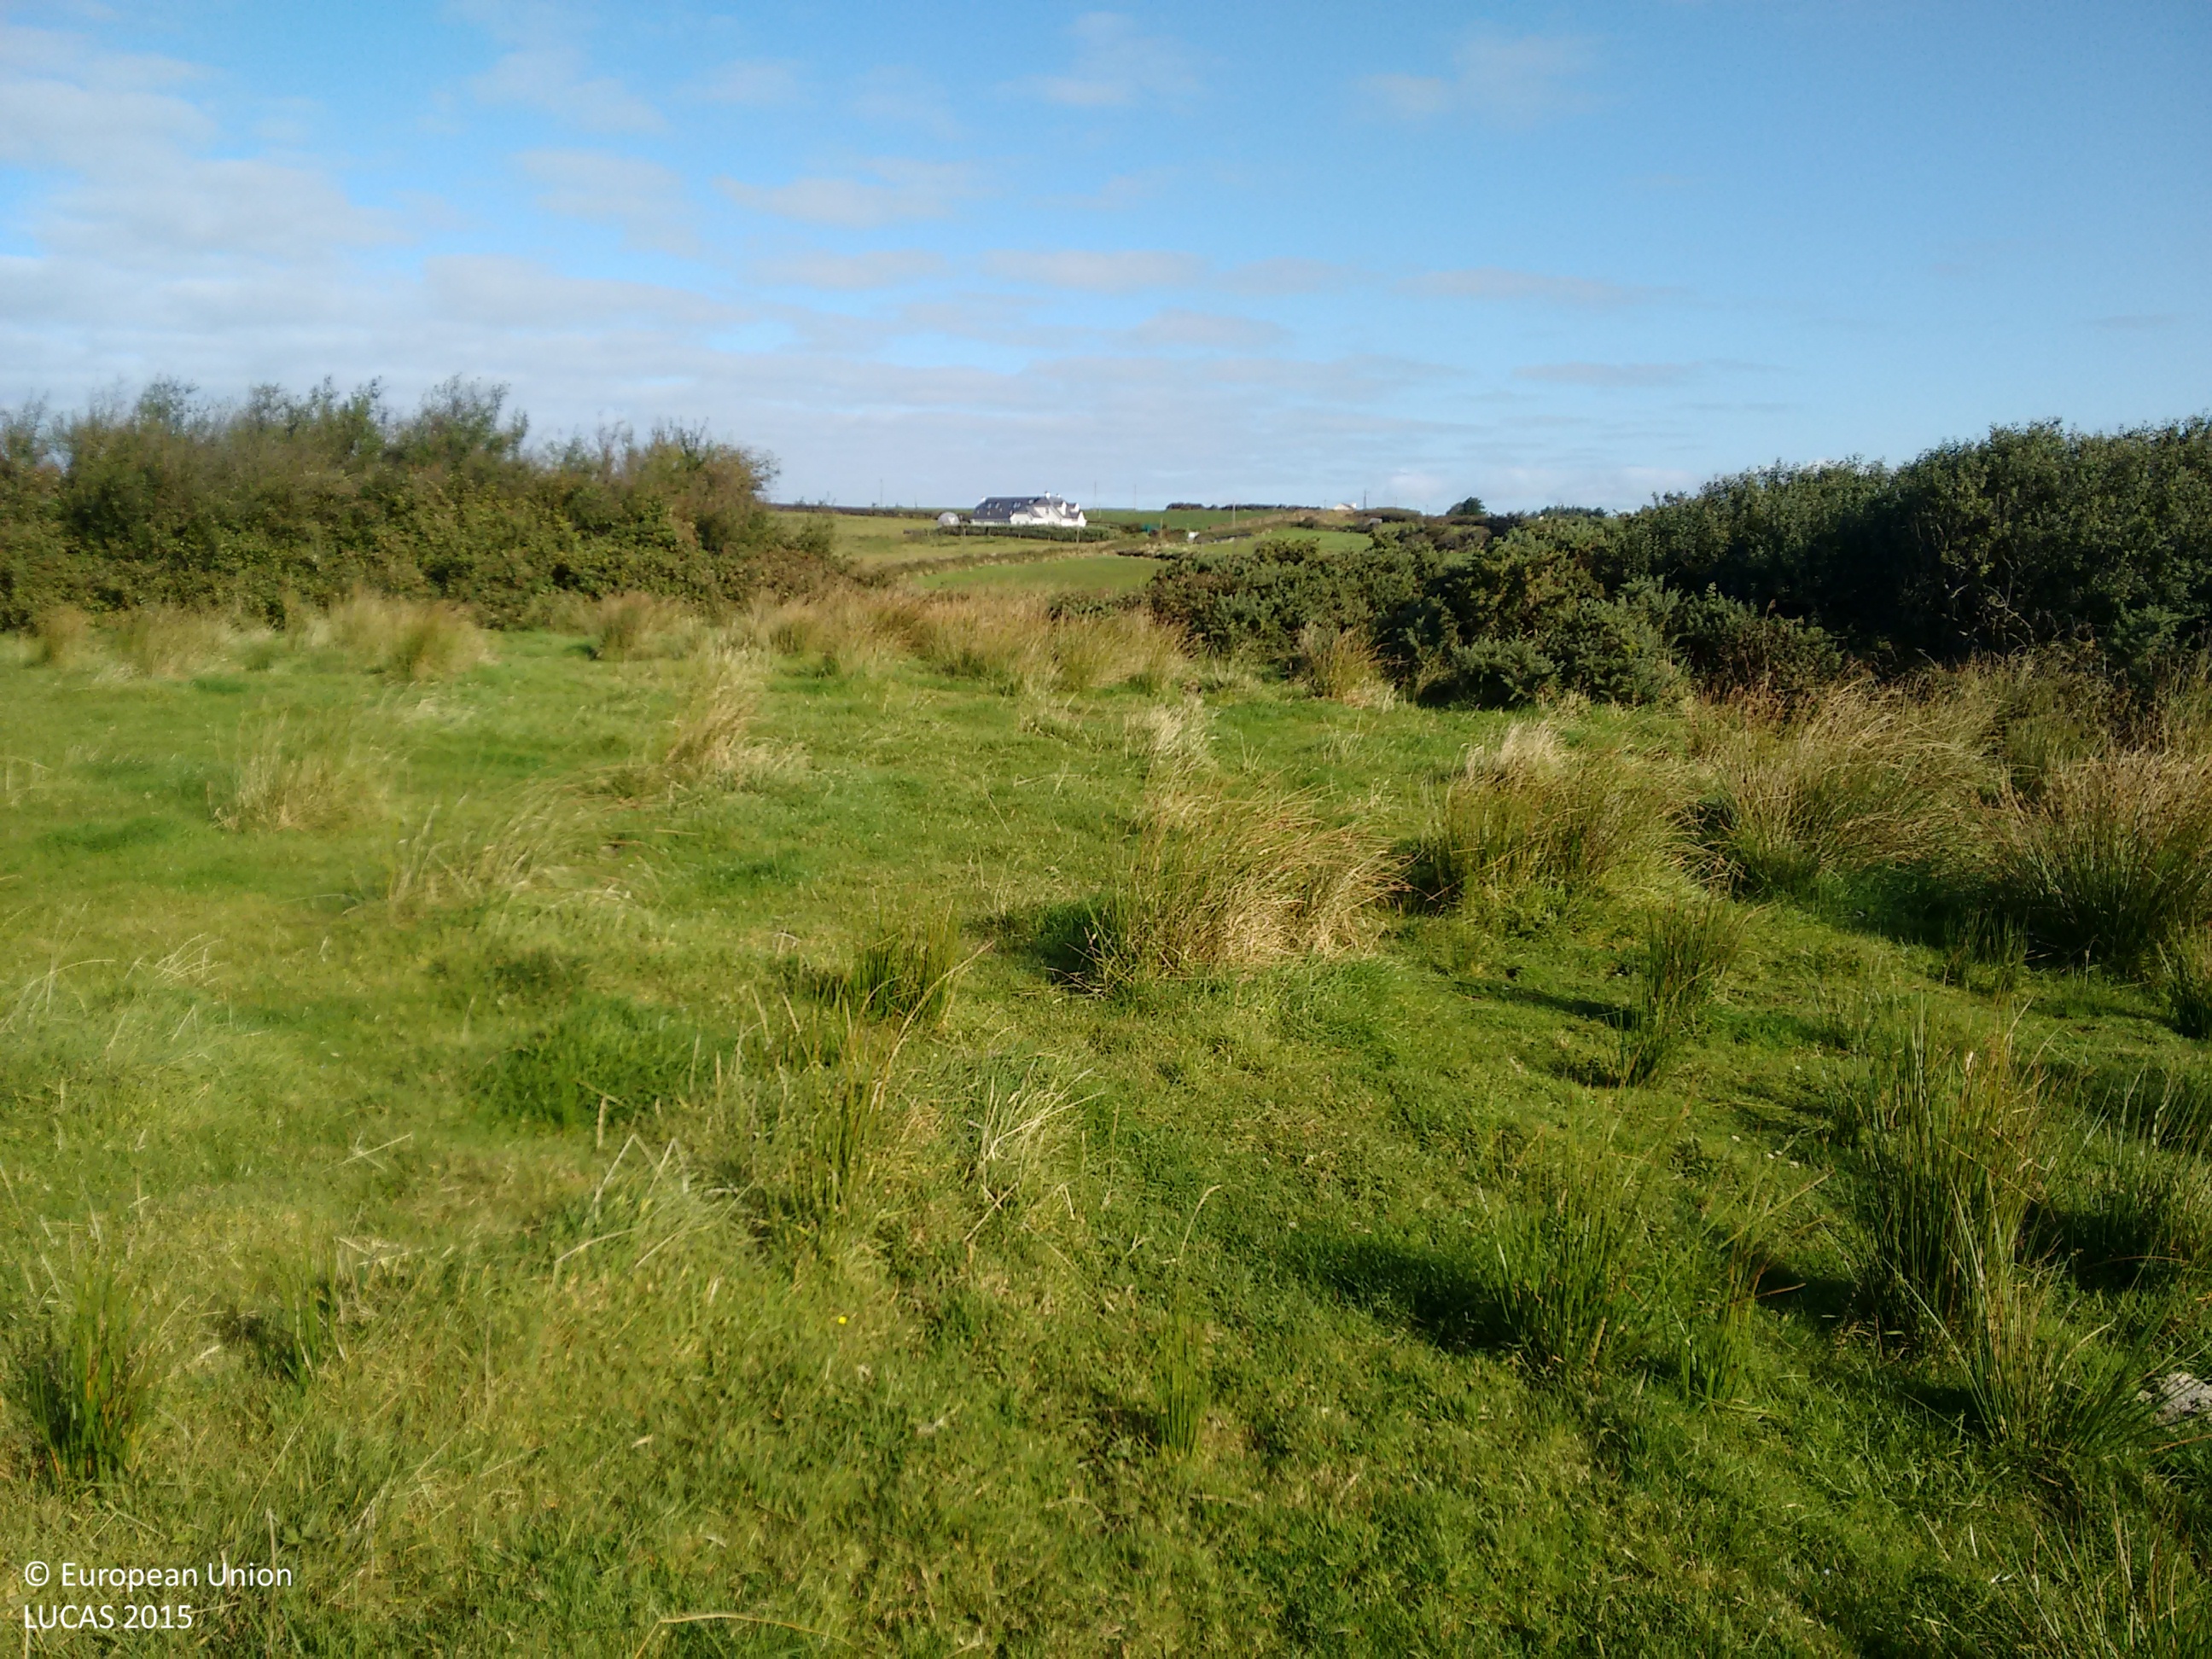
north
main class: Grassland
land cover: Grassland without tree/shrub cover
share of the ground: > 75 %
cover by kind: herbaceous plants 100 %
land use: Agriculture (excluding fallow land and kitchen gardens)
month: September
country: IE
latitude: 52.7913
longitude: -9.4031
